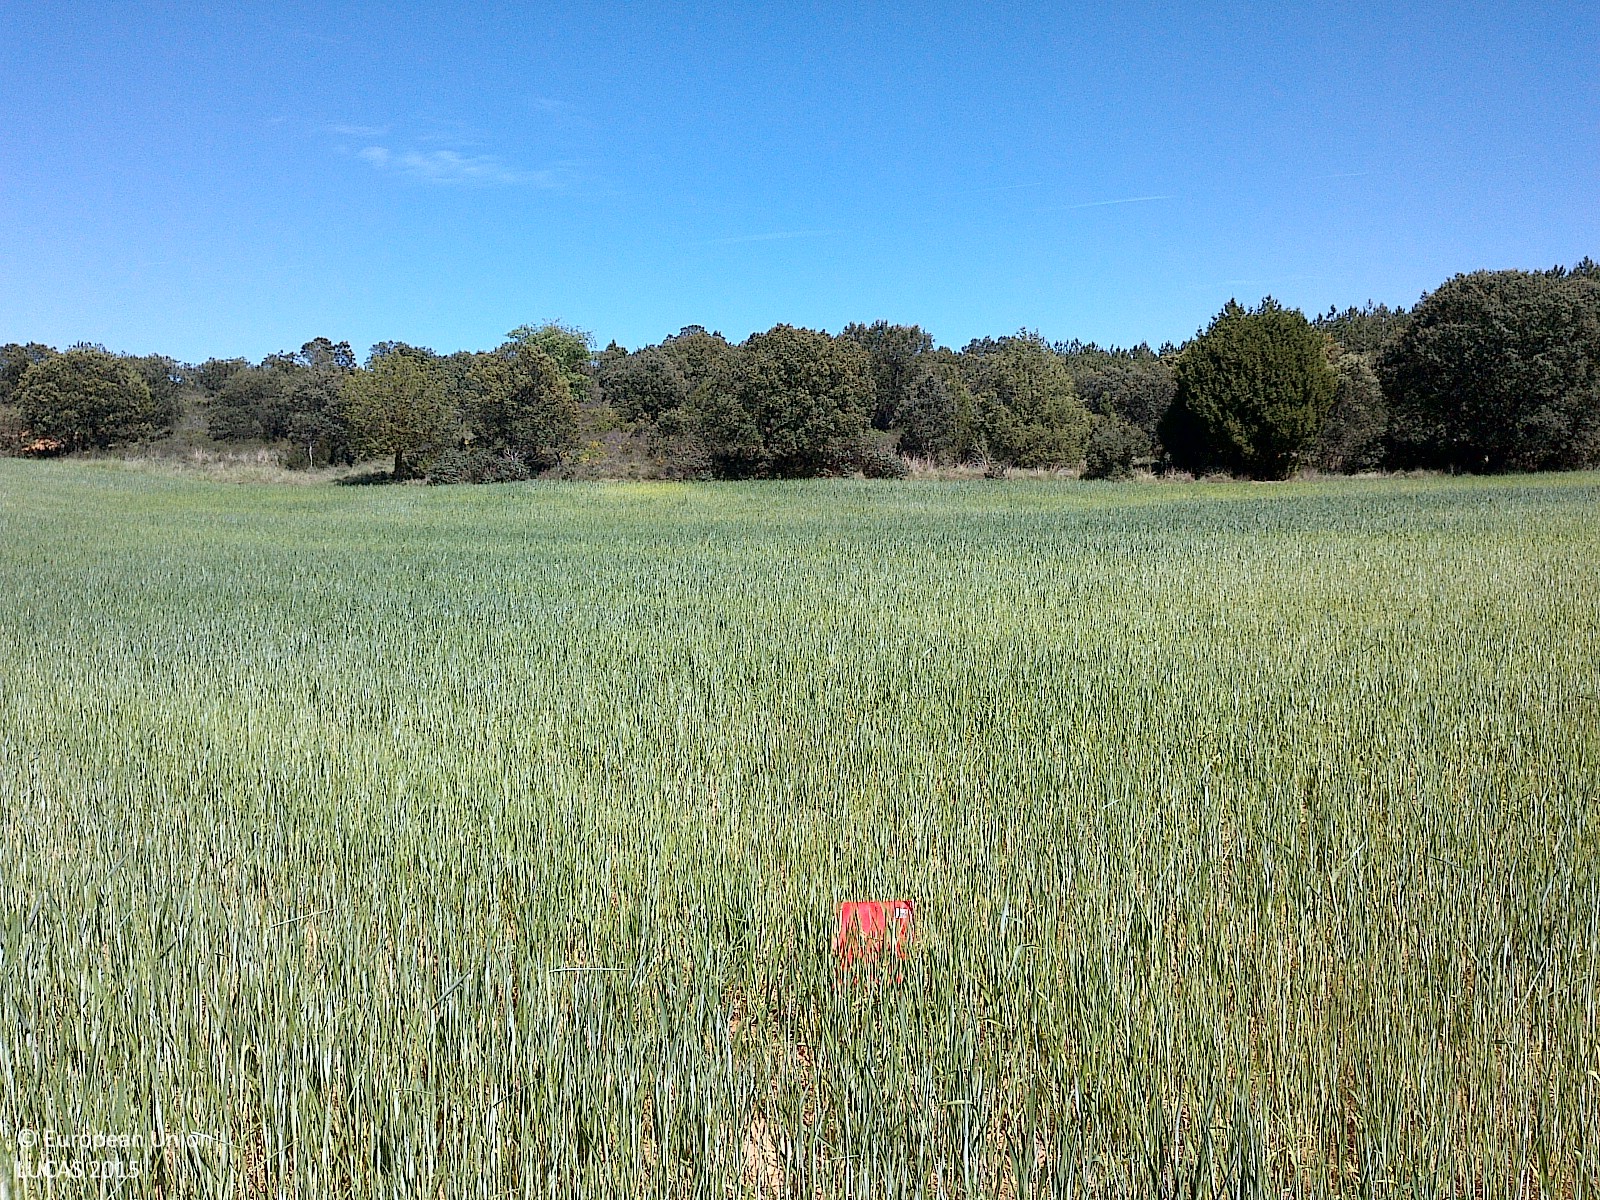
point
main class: Cropland
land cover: Barley
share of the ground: > 75 %
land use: Agriculture (excluding fallow land and kitchen gardens)
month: May
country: ES
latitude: 41.6147
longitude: -3.1129
